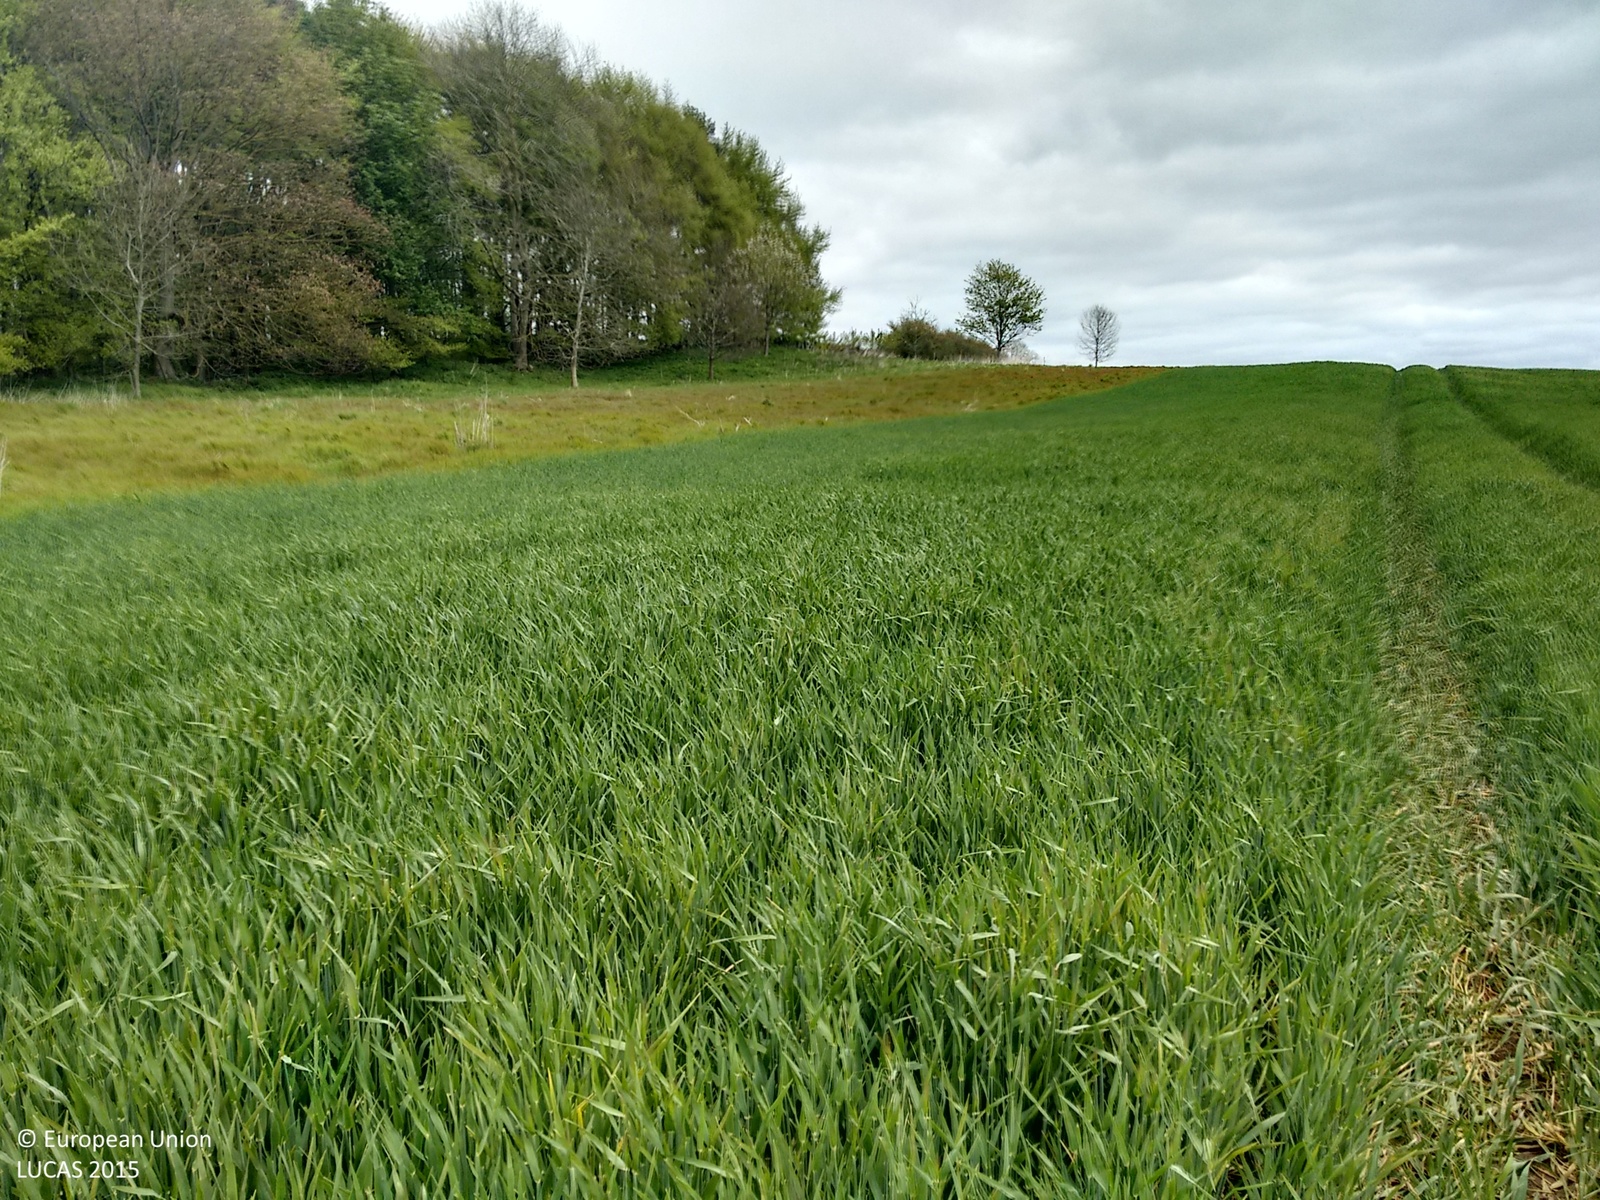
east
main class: Cropland
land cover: Barley
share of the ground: > 75 %
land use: Agriculture (excluding fallow land and kitchen gardens)
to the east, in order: Barley; Grass margins; Dry stone walls; Grass margins; Barley
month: May
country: GB
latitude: 55.0668
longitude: -2.0977
